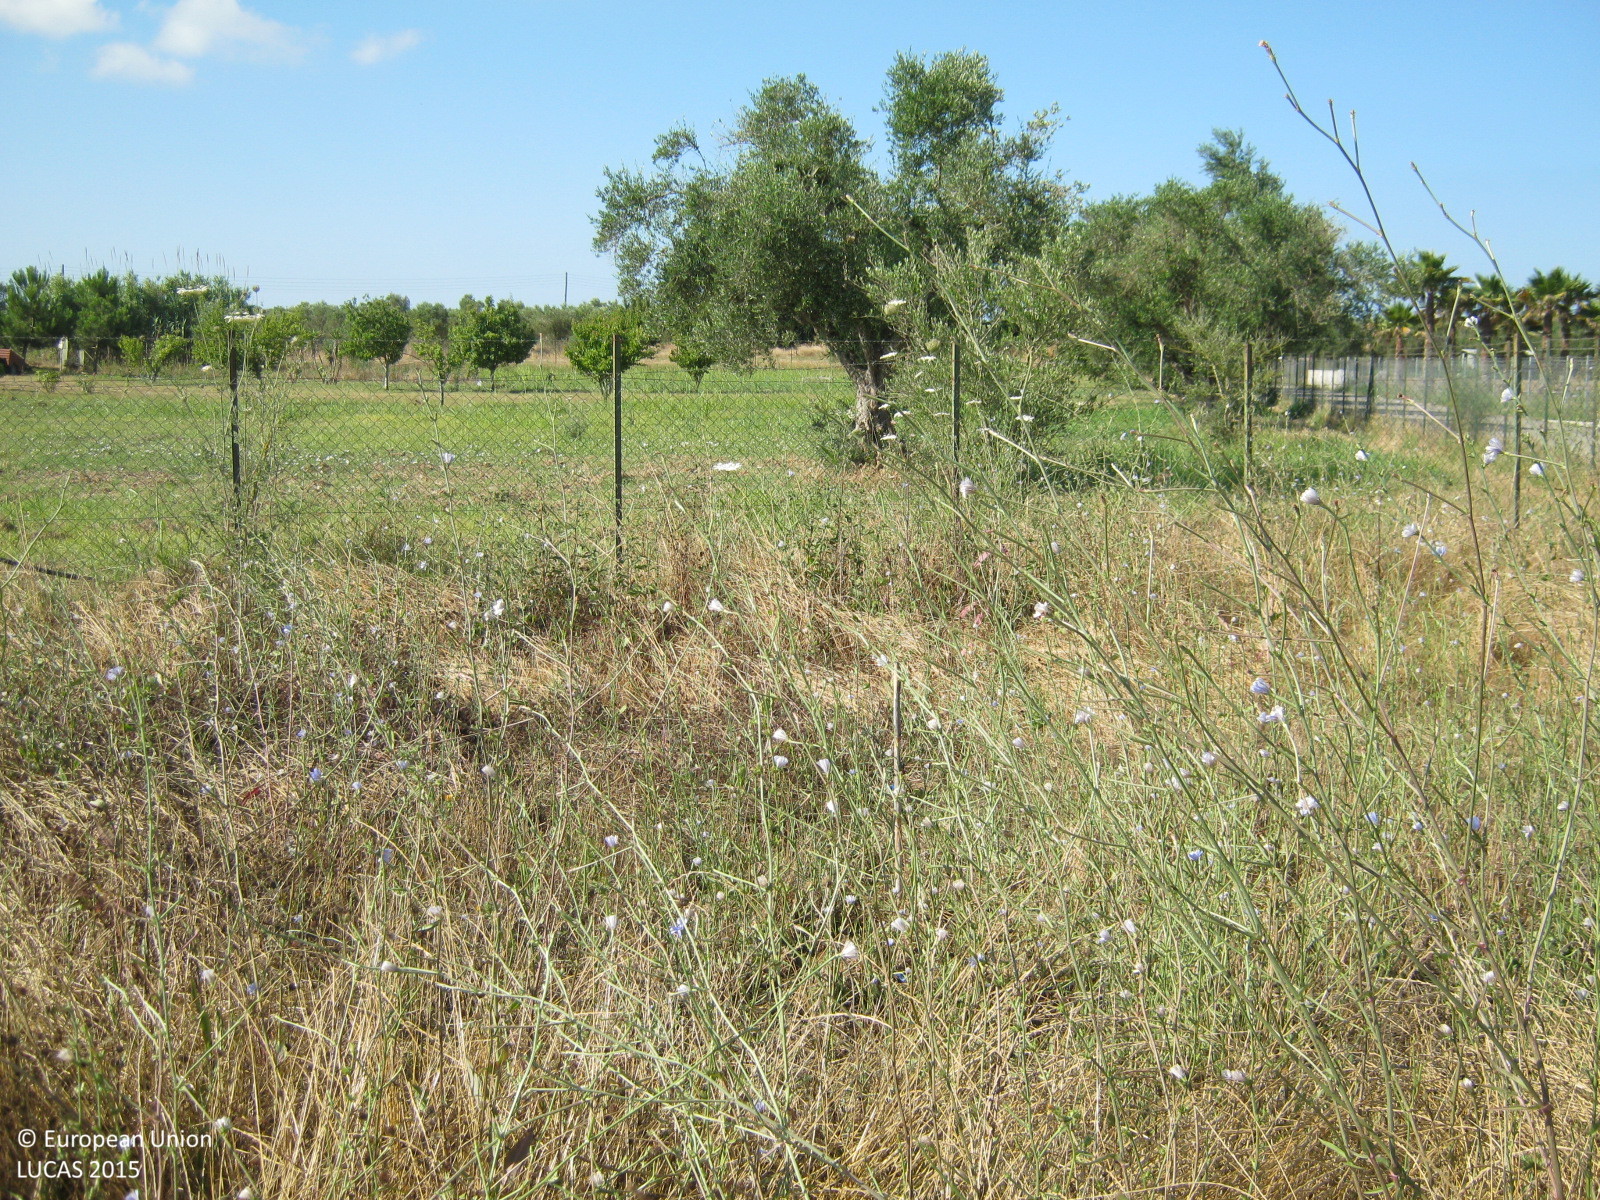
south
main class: Cropland
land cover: Olive groves
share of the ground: < 10 %
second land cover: Spontaneously vegetated surfaces
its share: > 75 %
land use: Agriculture (excluding fallow land and kitchen gardens)
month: June
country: GR
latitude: 37.8519
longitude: 21.1999
